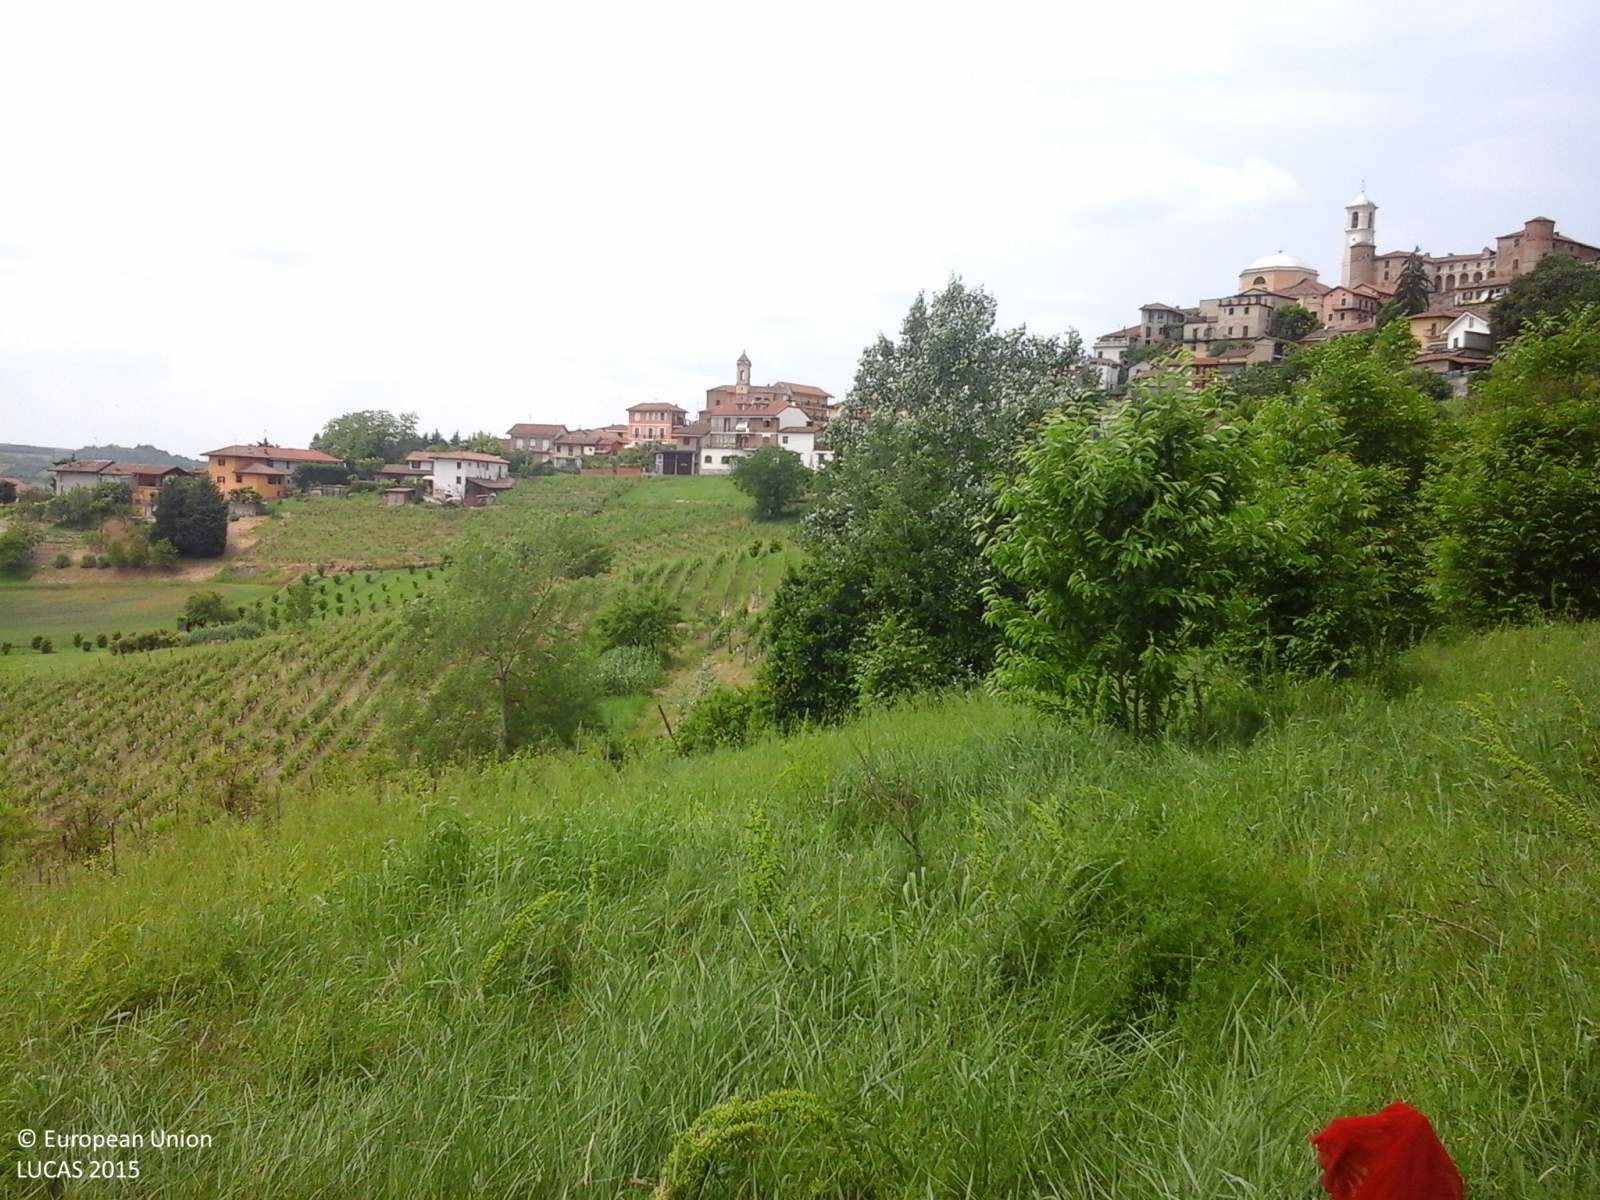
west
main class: Grassland
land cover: Grassland with sparse tree/shrub cover
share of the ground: > 75 %
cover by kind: herbaceous plants 85 %, shrubs 10 %, broadleaved forest trees 5 %
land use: Agriculture (excluding fallow land and kitchen gardens)
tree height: < 5 m
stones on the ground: < 10 %
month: May
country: IT
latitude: 44.8227
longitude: 8.2455
